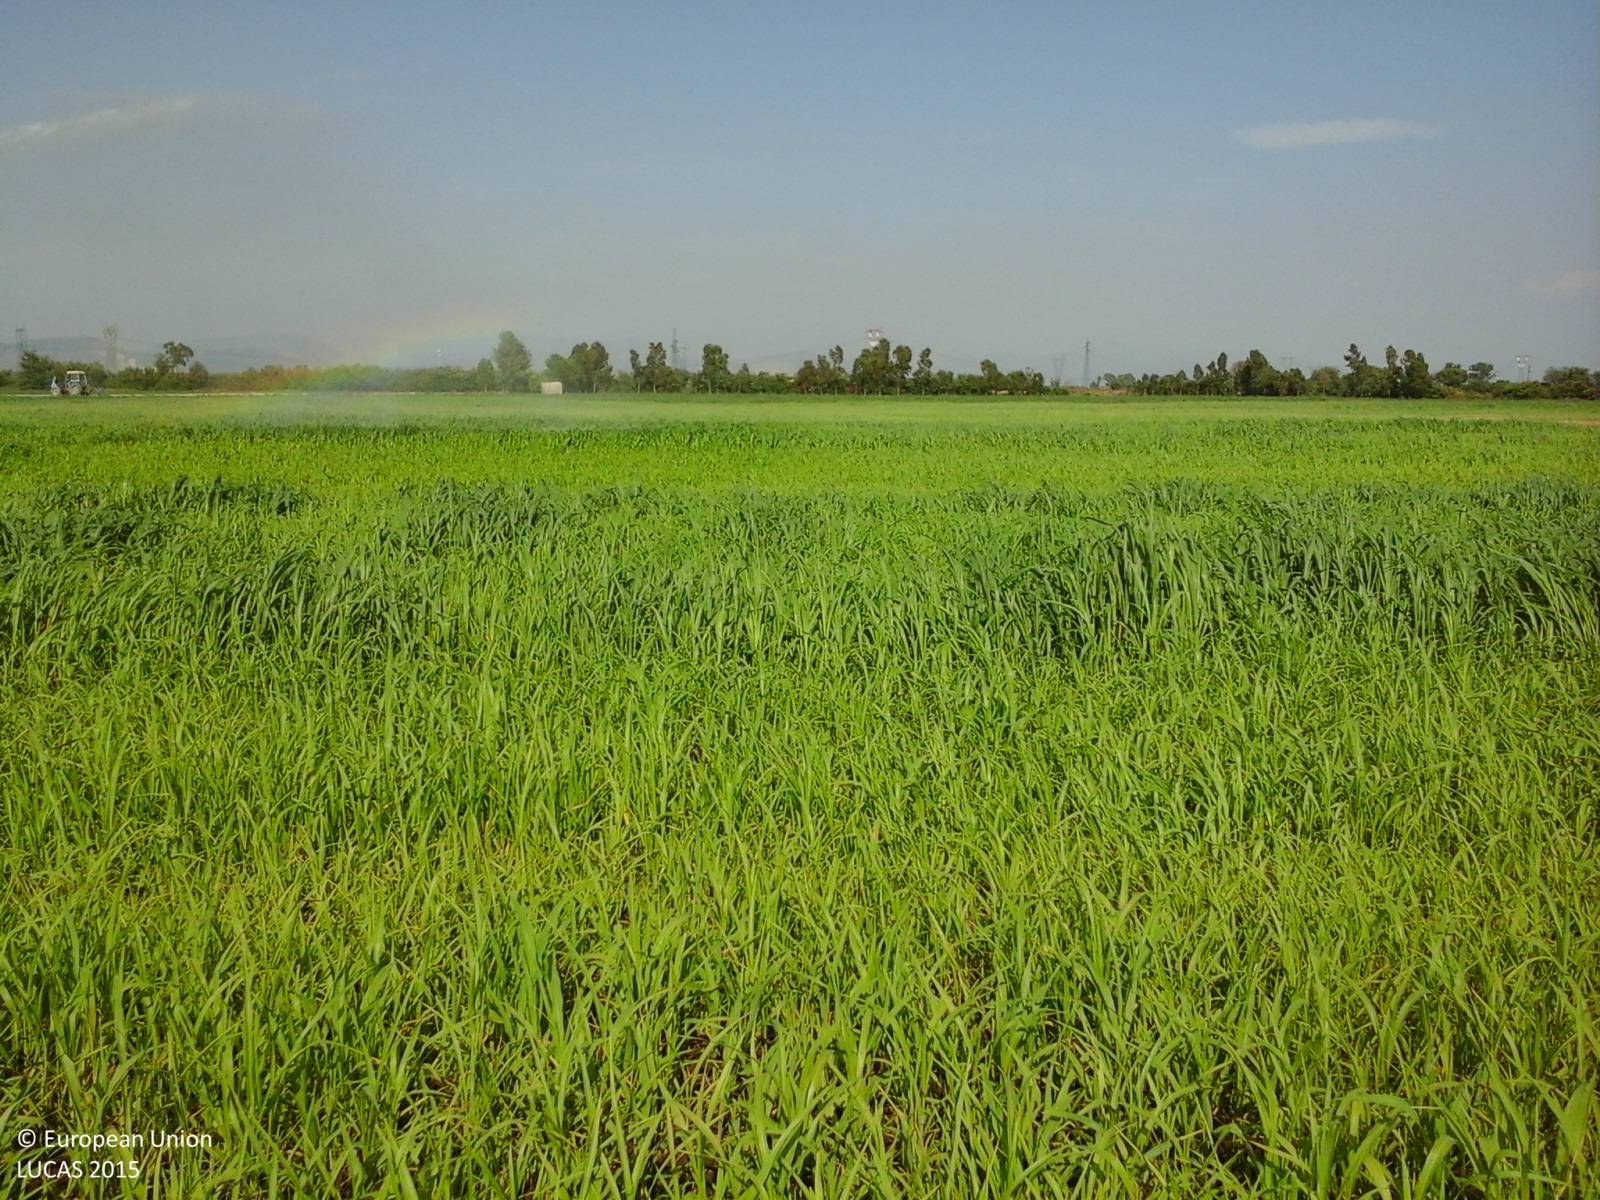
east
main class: Cropland
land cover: Other cereals
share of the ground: 50 - 75 %
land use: Agriculture (excluding fallow land and kitchen gardens)
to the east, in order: Other cereals; Tomatoes
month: July
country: IT
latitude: 41.0487
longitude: 14.1591
